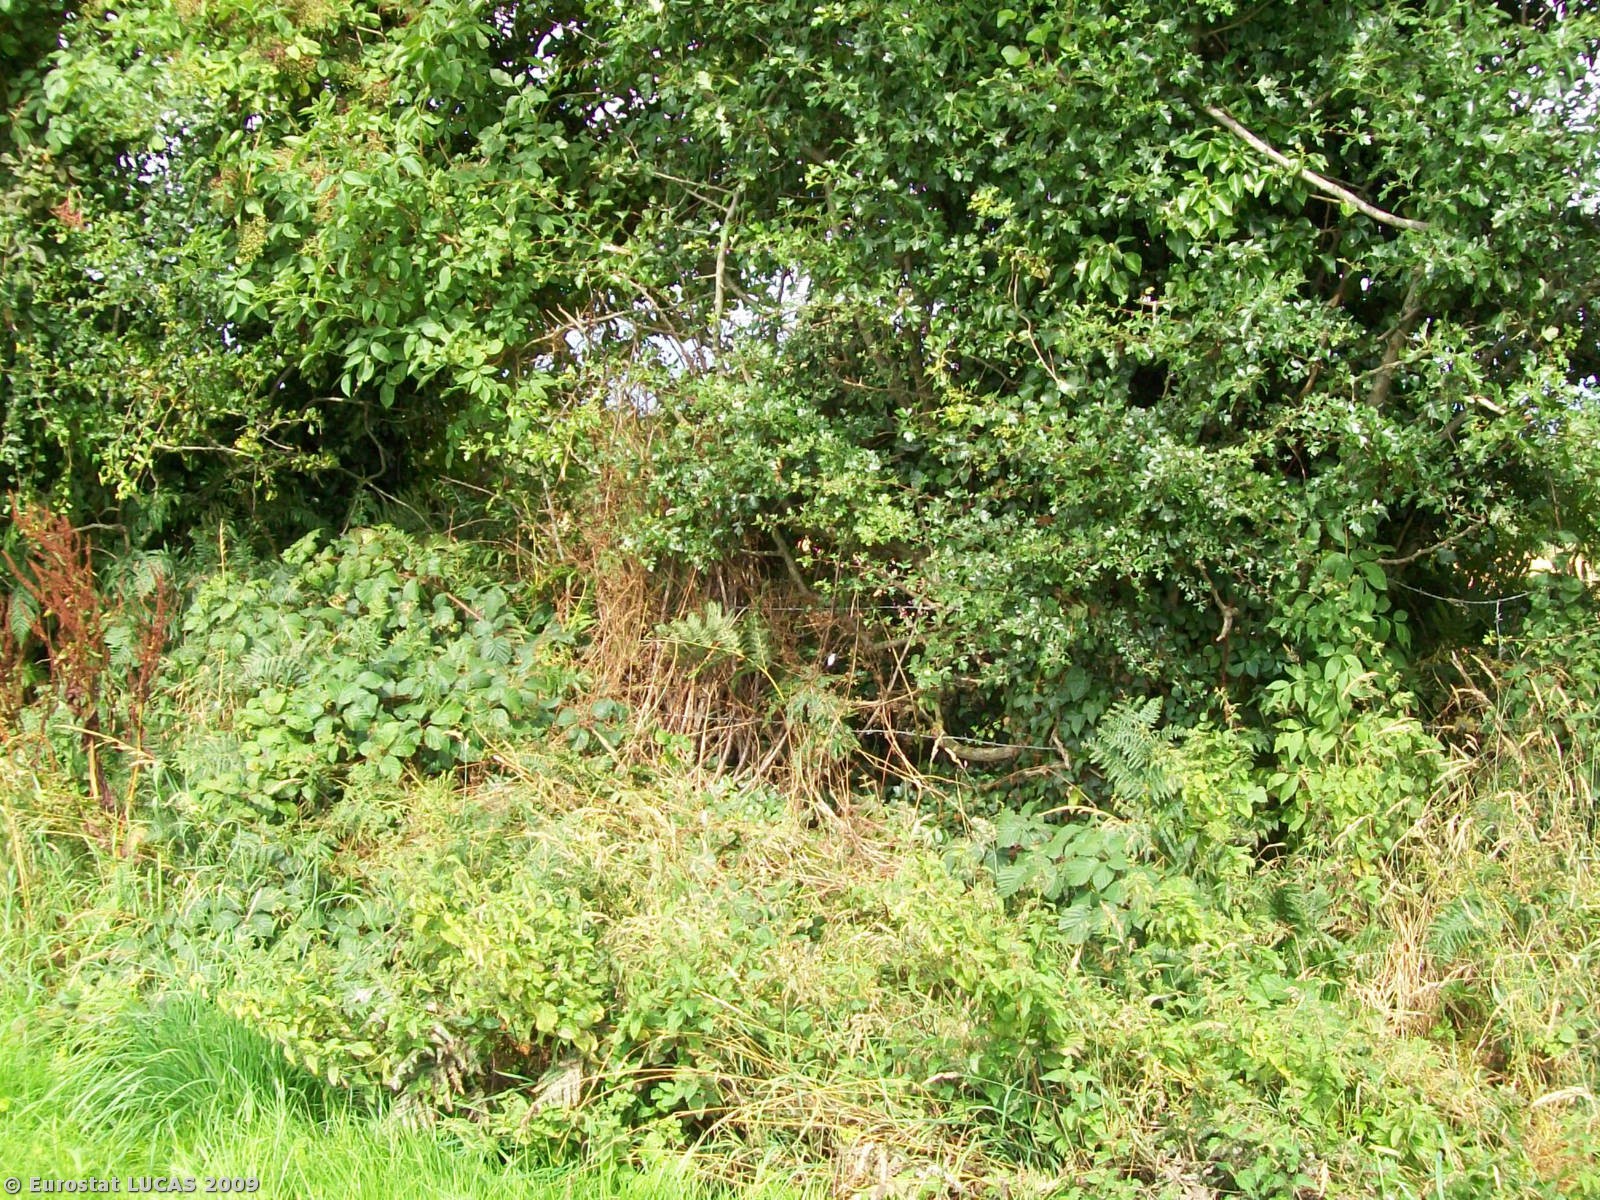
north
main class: Grassland
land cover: Grassland without tree/shrub cover
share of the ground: > 75 %
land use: Agriculture (excluding fallow land and kitchen gardens)
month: August
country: GB
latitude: 54.4867
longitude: -6.0574
